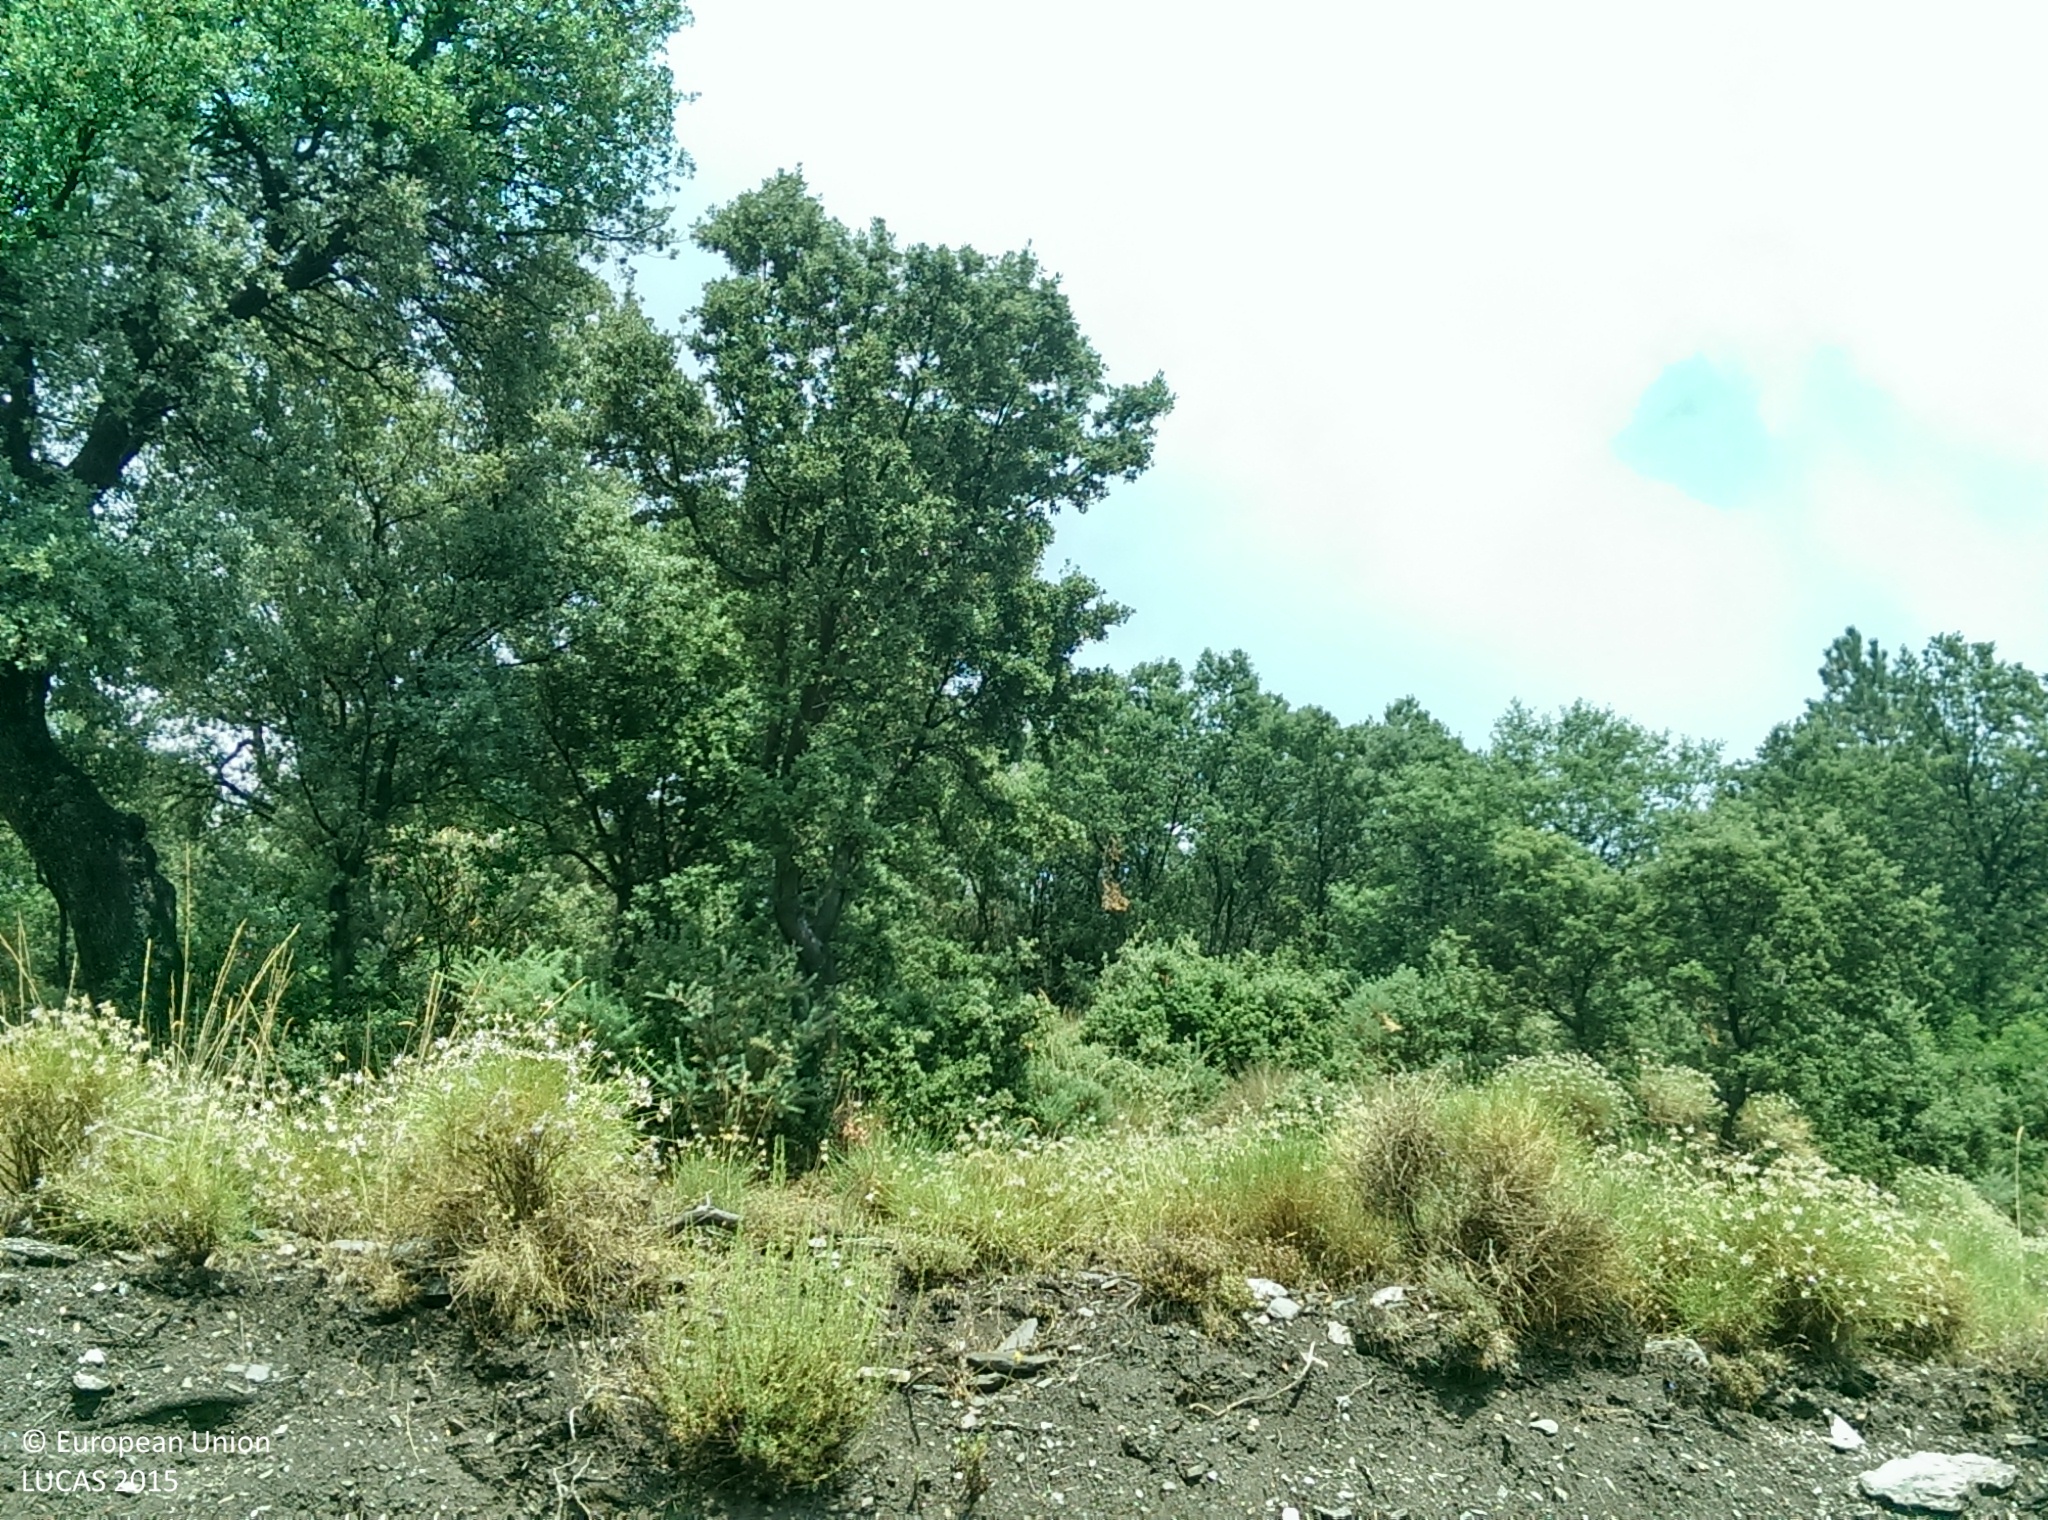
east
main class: Woodland
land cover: Broadleaved woodland
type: broadleaved evergreen forest
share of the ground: 50 - 75 %
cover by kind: broadleaved forest trees 65 %, shrubs 15 %, herbaceous plants 15 %, unconsolidated bare surface 5 %
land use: Forestry
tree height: > 5 m
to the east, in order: Tracks; Broadleaved woodland; Ditches and canals; Broadleaved woodland; Tracks; Shrubland with sparse tree cover; Tracks; Shrubland with sparse tree cover
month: July
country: ES
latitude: 37.0145
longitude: -3.1437
